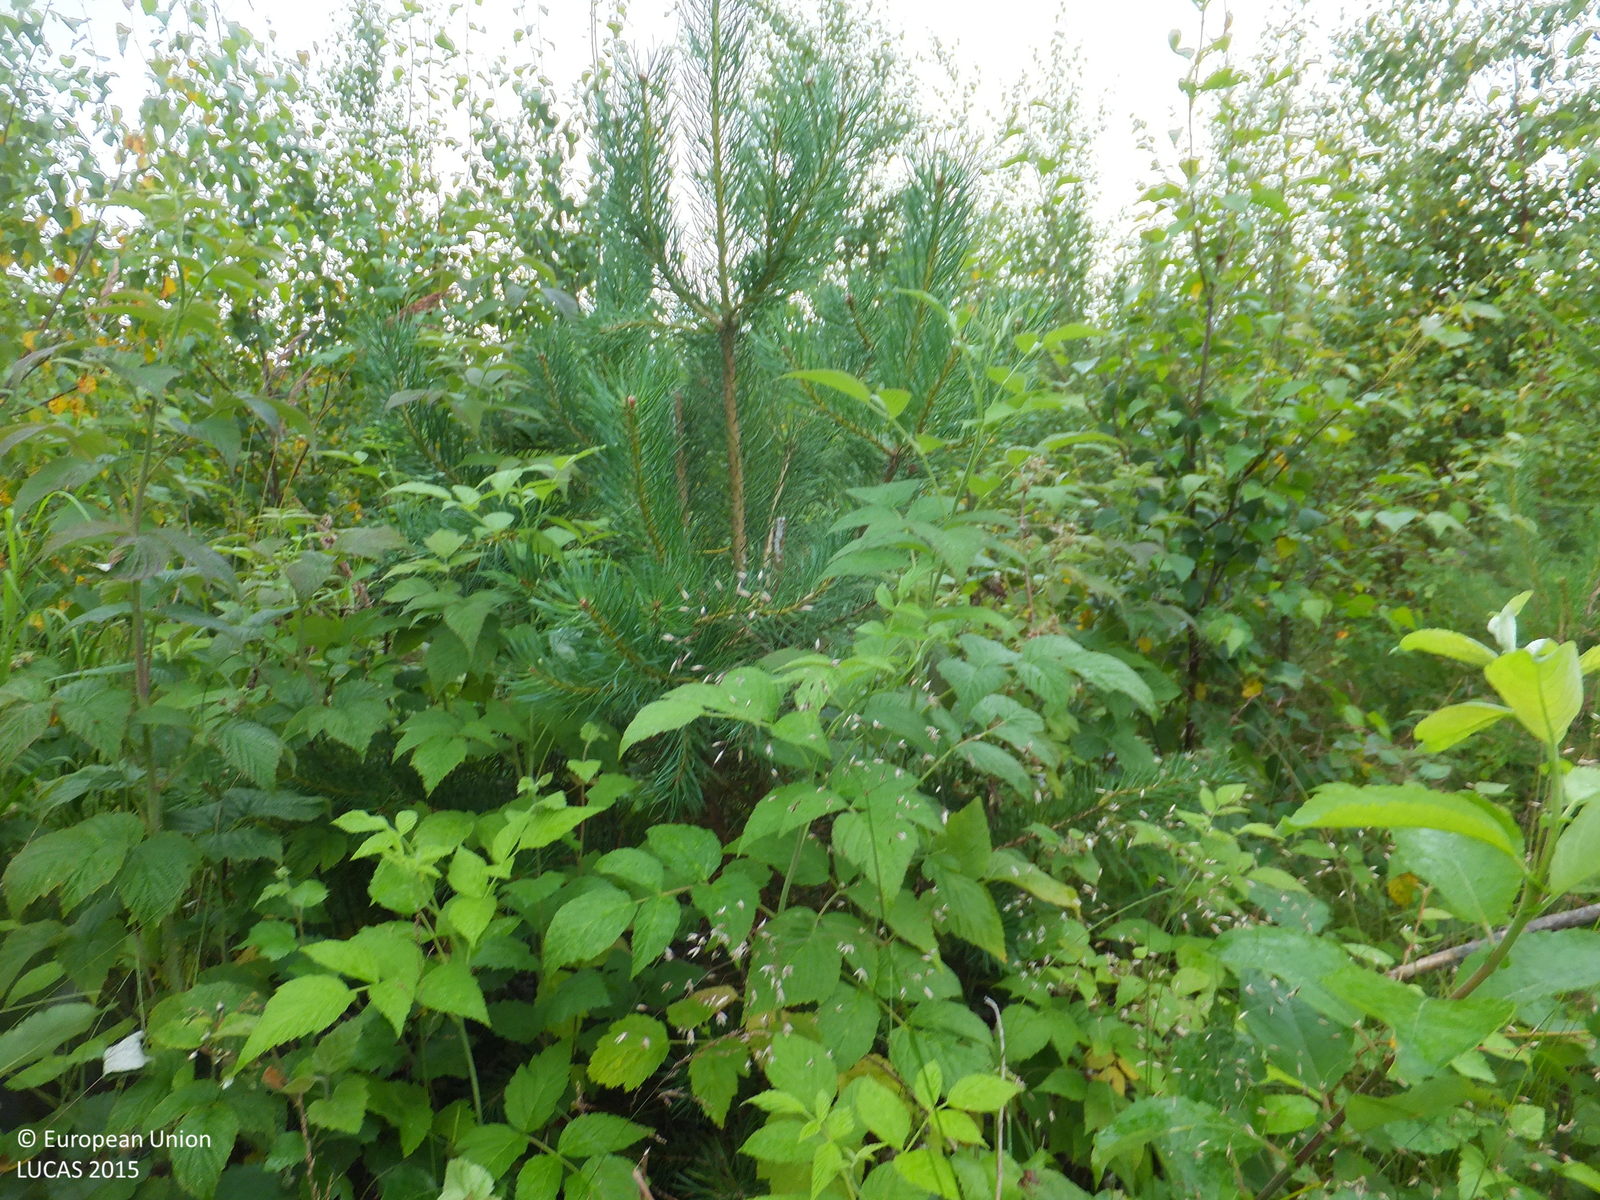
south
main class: Woodland
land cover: Pine dominated mixed woodland
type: boreal forest
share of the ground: > 75 %
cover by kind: coniferous forest trees 40 %, broadleaved forest trees 40 %, shrubs 10 %, herbaceous plants 10 %
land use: Forestry
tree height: < 5 m
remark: Nursery
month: July
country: FI
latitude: 63.1033
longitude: 21.9518
